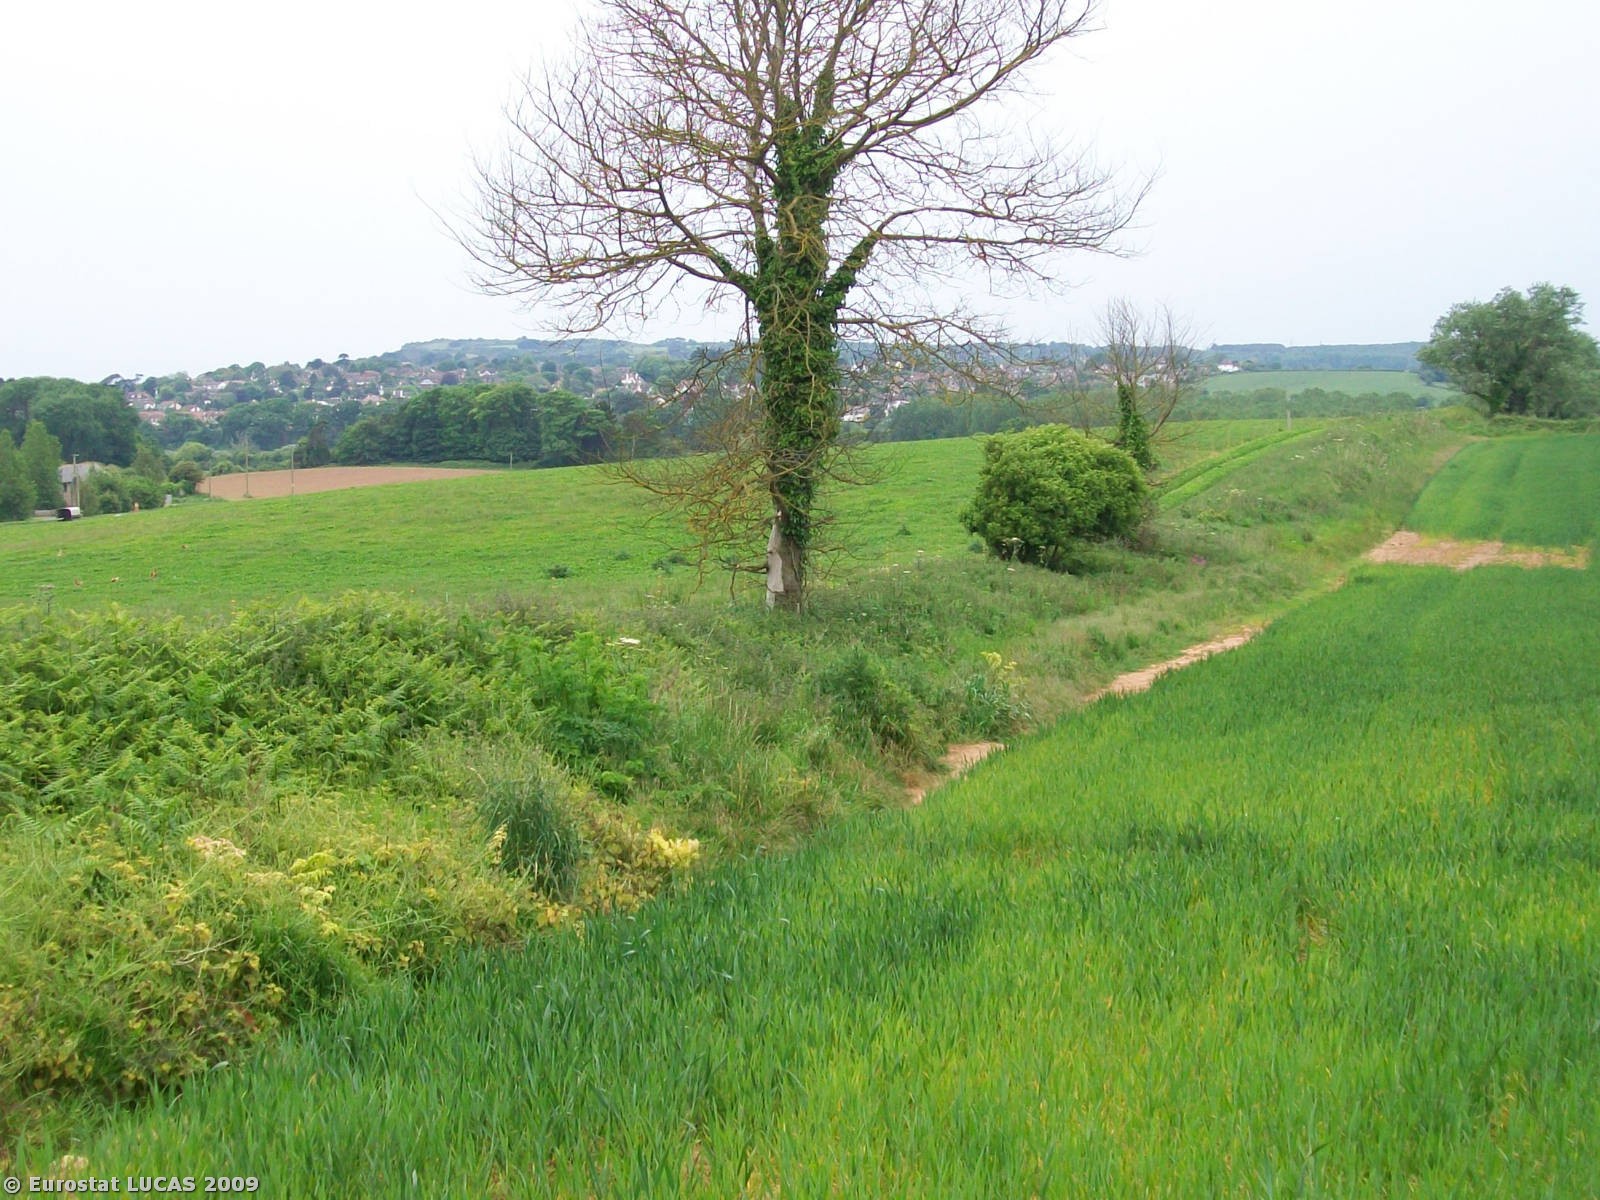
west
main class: Cropland
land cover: Common wheat
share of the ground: 50 - 75 %
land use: Agriculture (excluding fallow land and kitchen gardens)
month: May
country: GB
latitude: 50.6401
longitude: -3.3013
